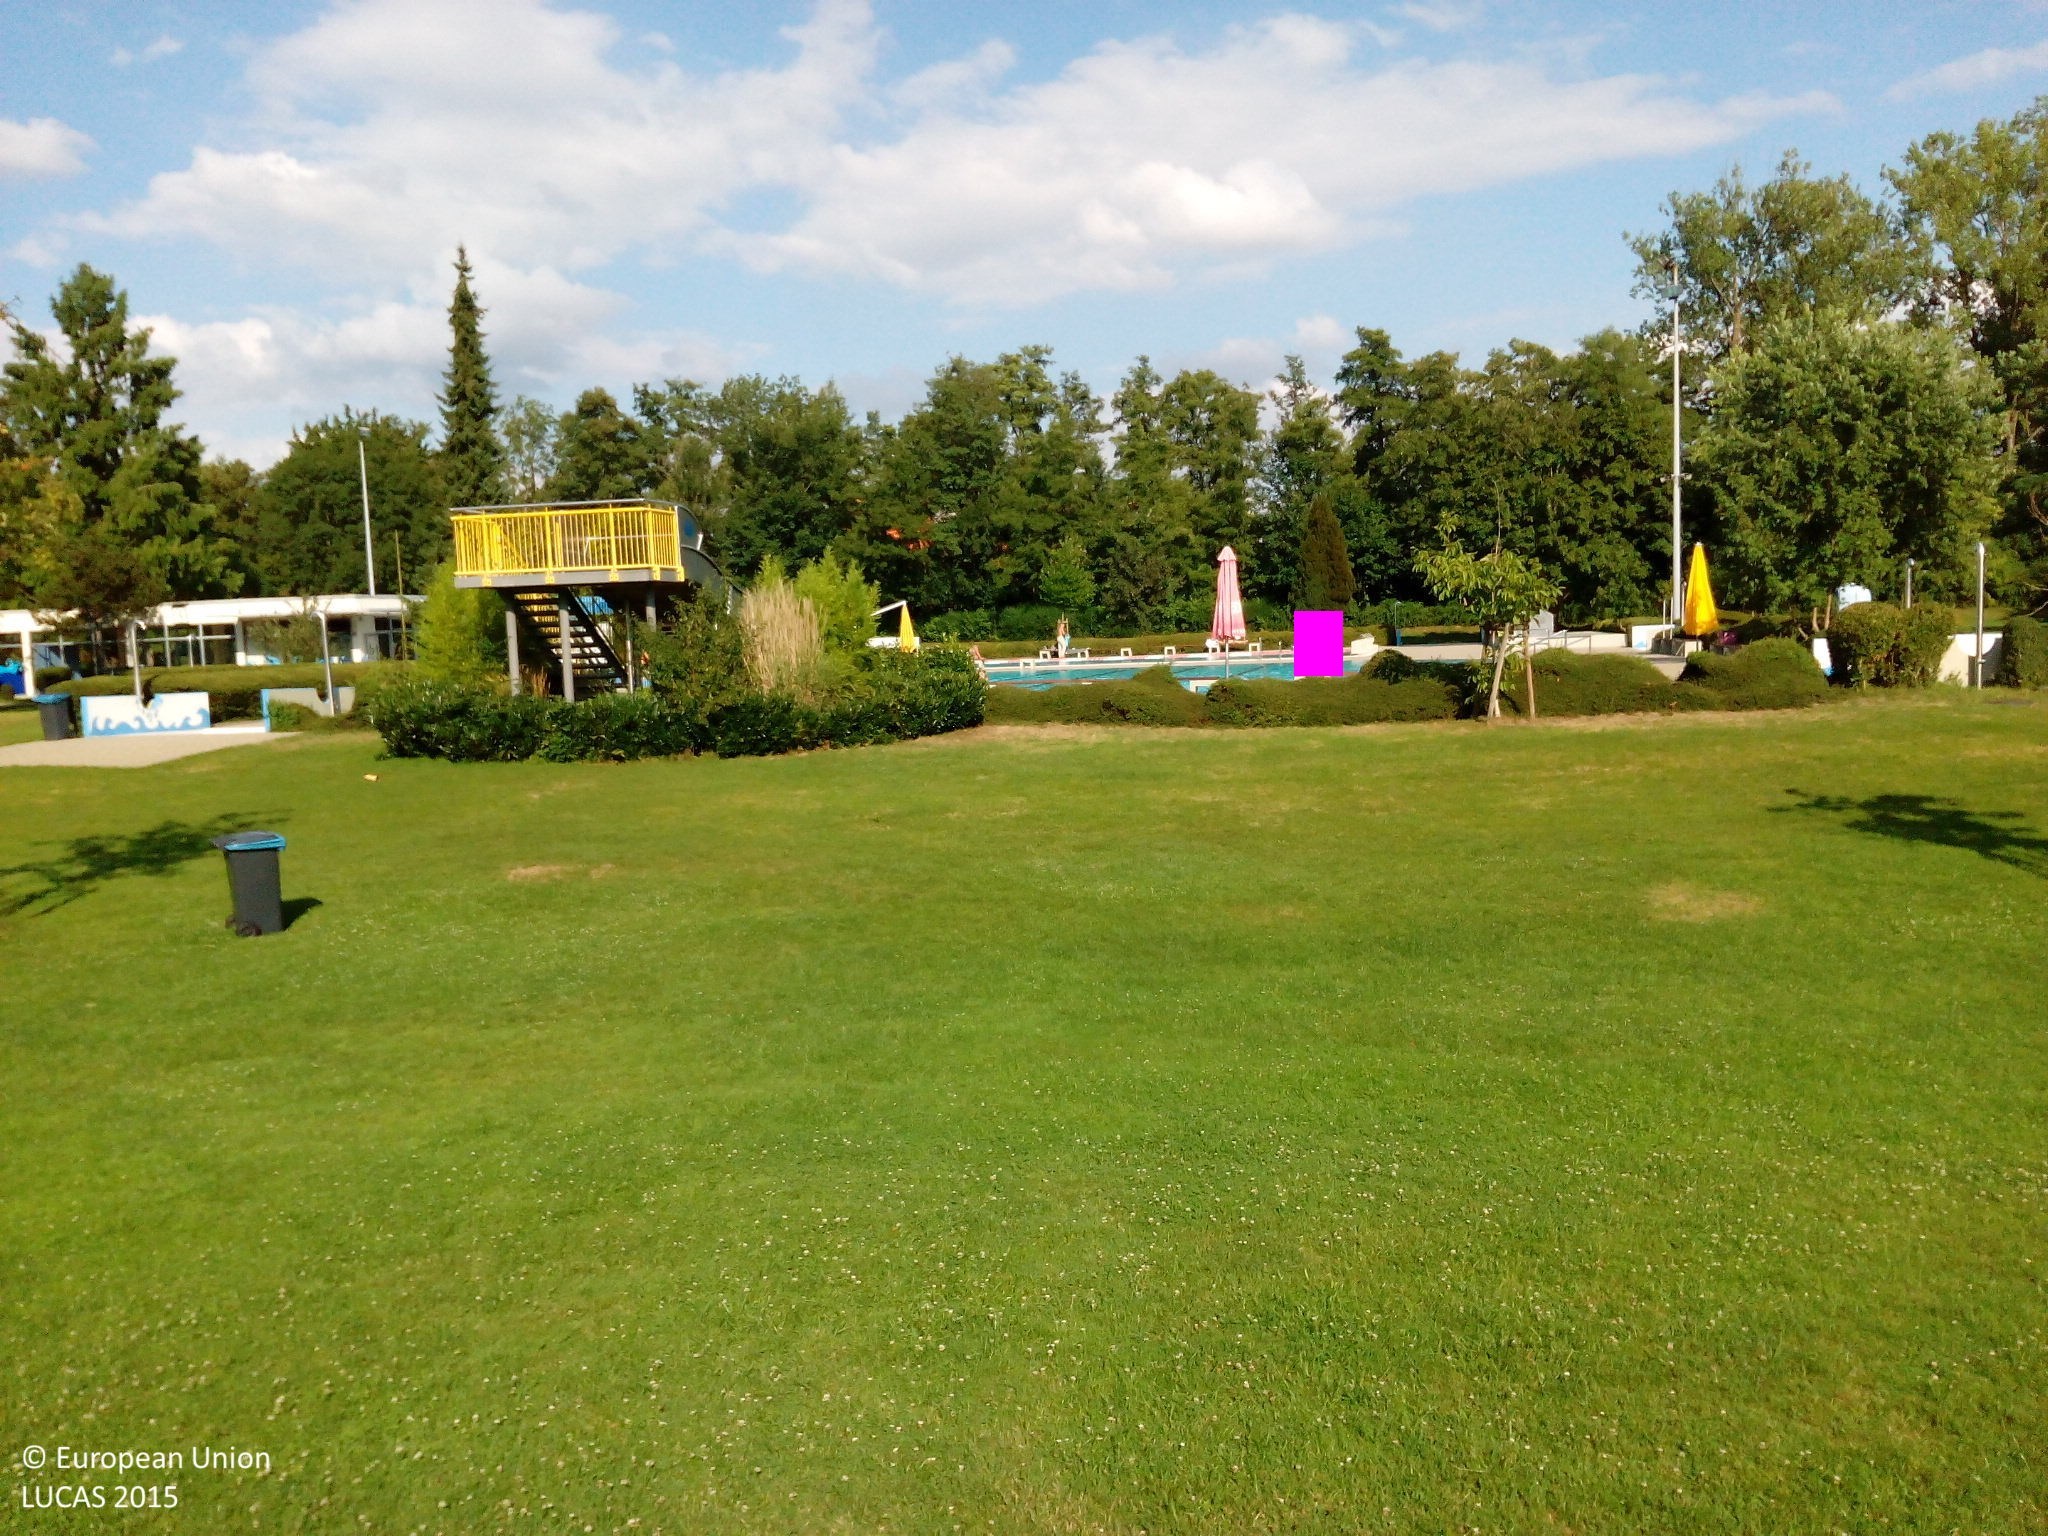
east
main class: Grassland
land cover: Grassland without tree/shrub cover
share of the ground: > 75 %
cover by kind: herbaceous plants 95 %, unconsolidated bare surface 5 %
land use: Amenities, museums, leisure
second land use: Sport
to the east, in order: Grassland without tree/shrub cover; Artificial constructions in urban areas; Grass margins; Tracks; Grass margins; Lines of trees; Inland fresh running water; Lines of trees; Grass margins; Tracks; Grassland without tree/shrub cover; Artificial constructions in urban areas
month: August
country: DE
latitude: 48.9520
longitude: 8.5667
